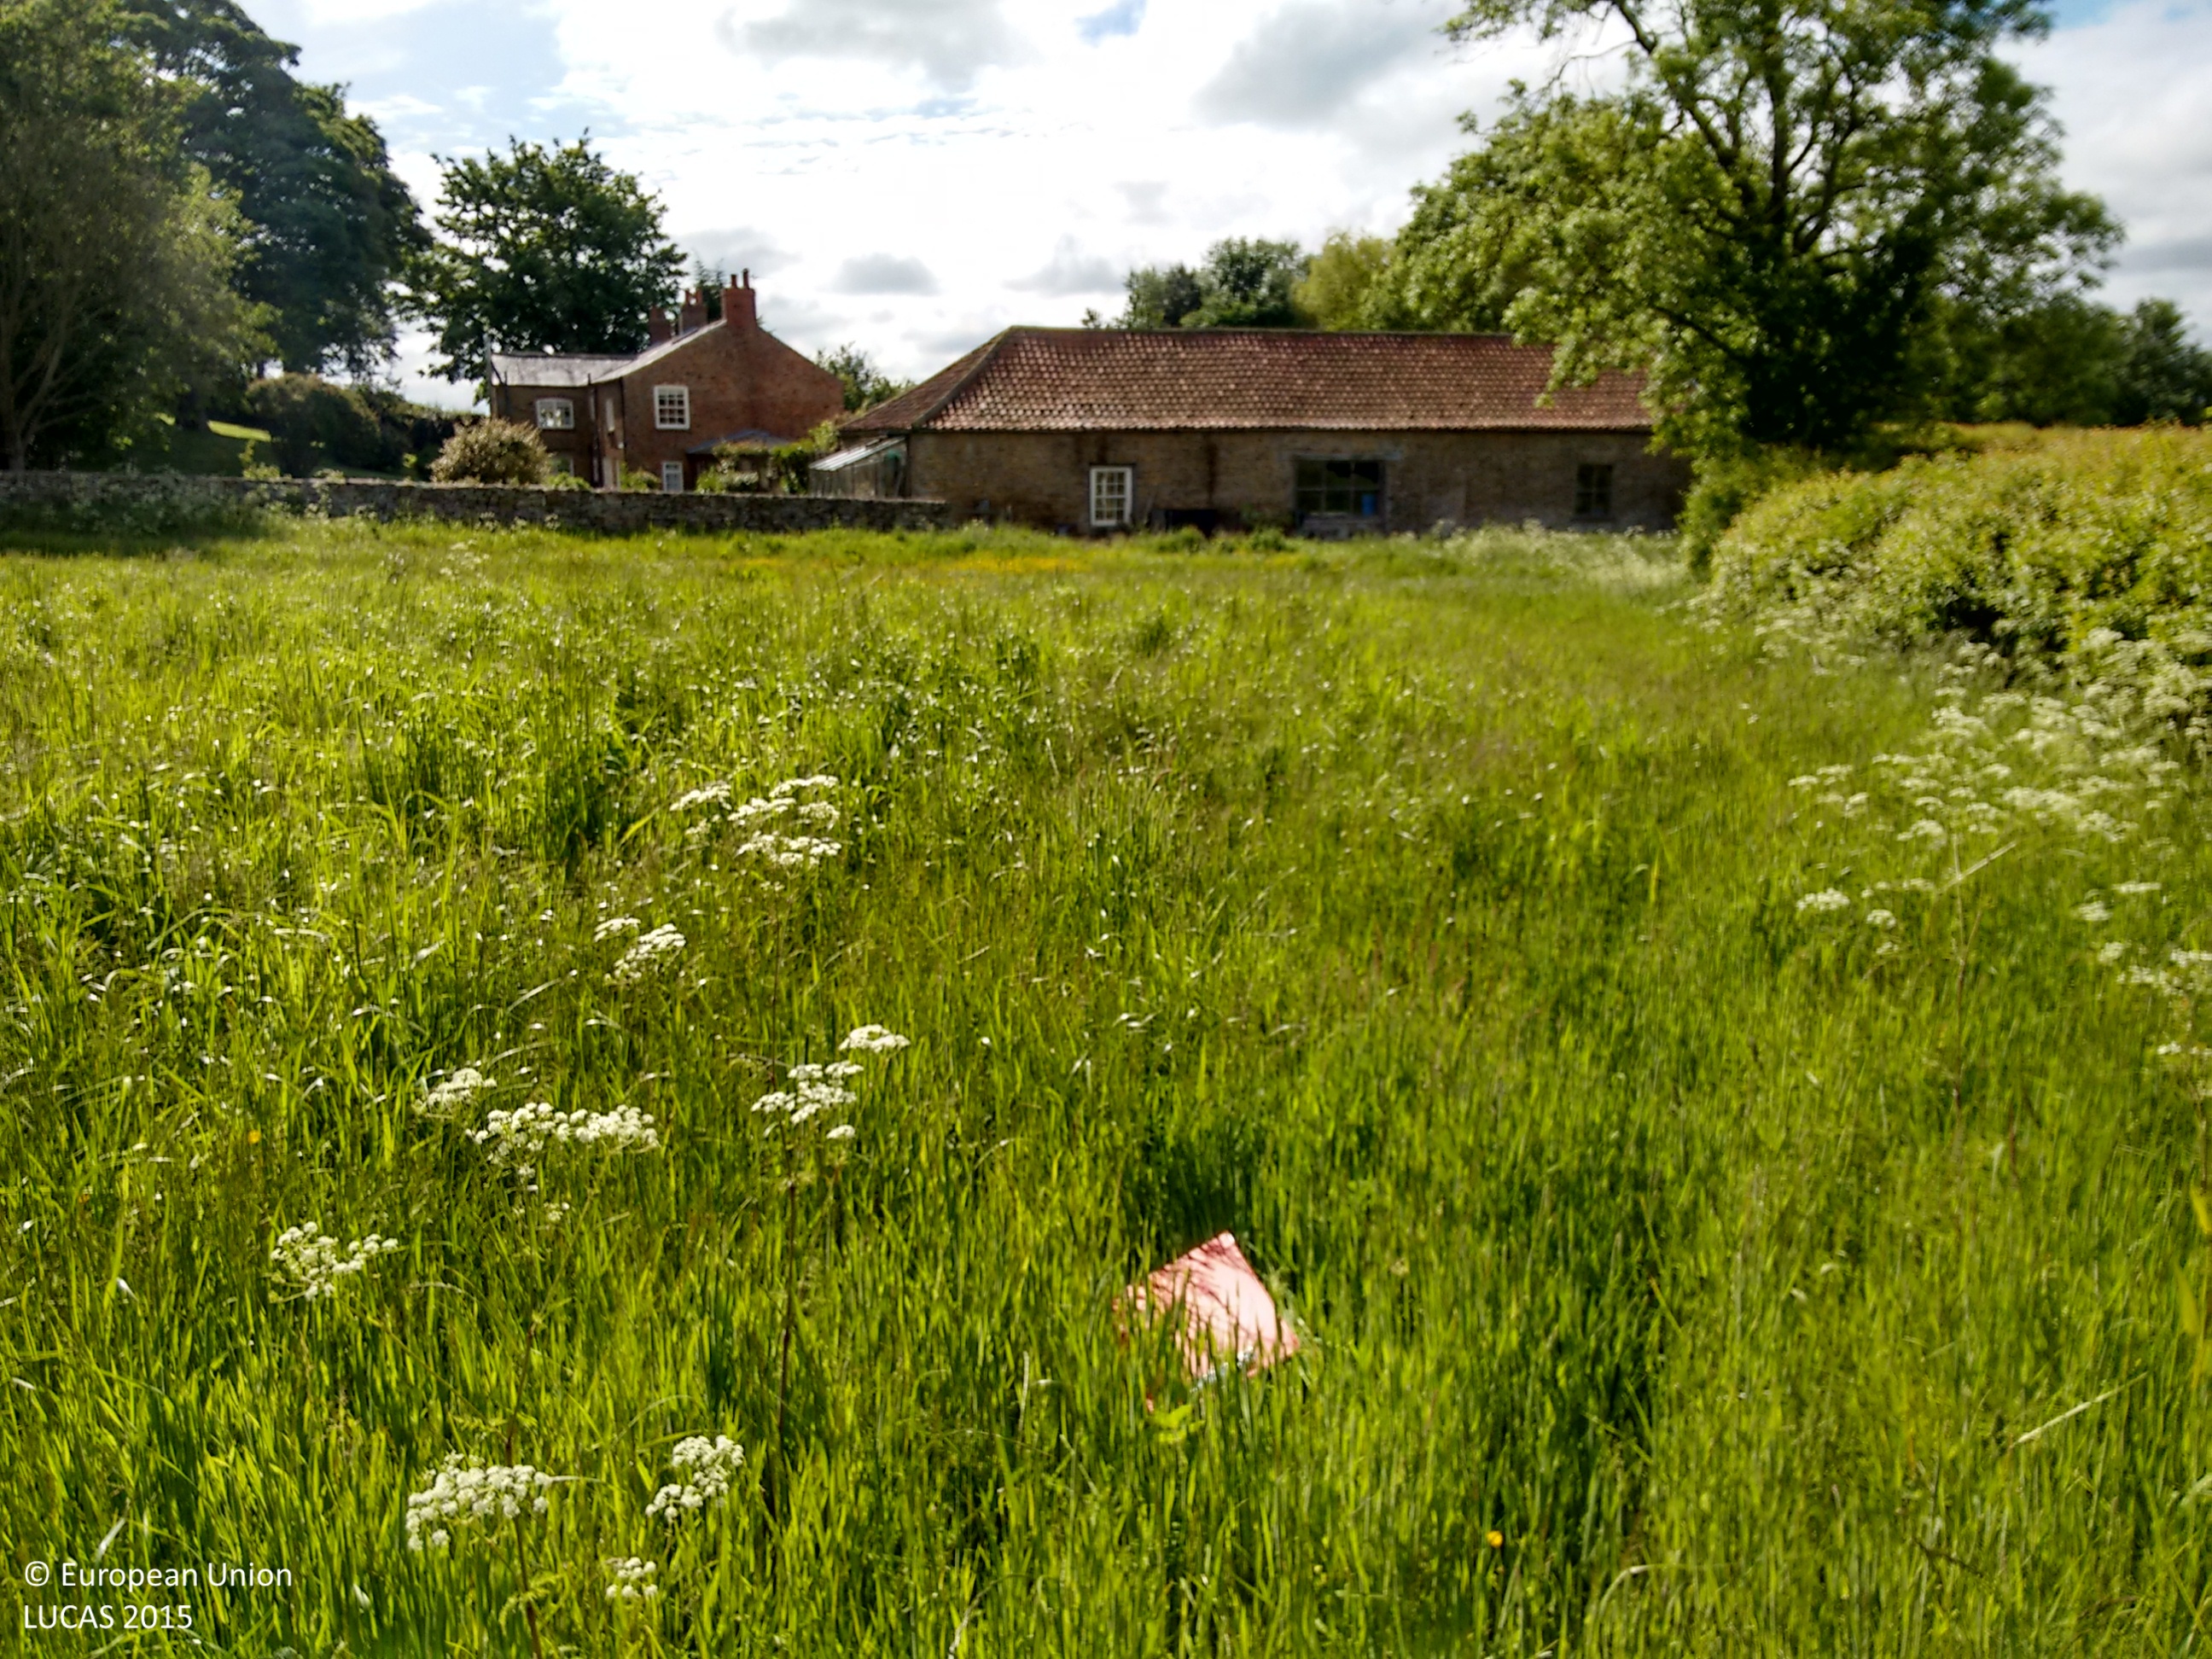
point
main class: Grassland
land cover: Grassland without tree/shrub cover
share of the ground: > 75 %
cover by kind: herbaceous plants 100 %
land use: Agriculture (excluding fallow land and kitchen gardens)
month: June
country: GB
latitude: 54.1266
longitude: -1.0763
